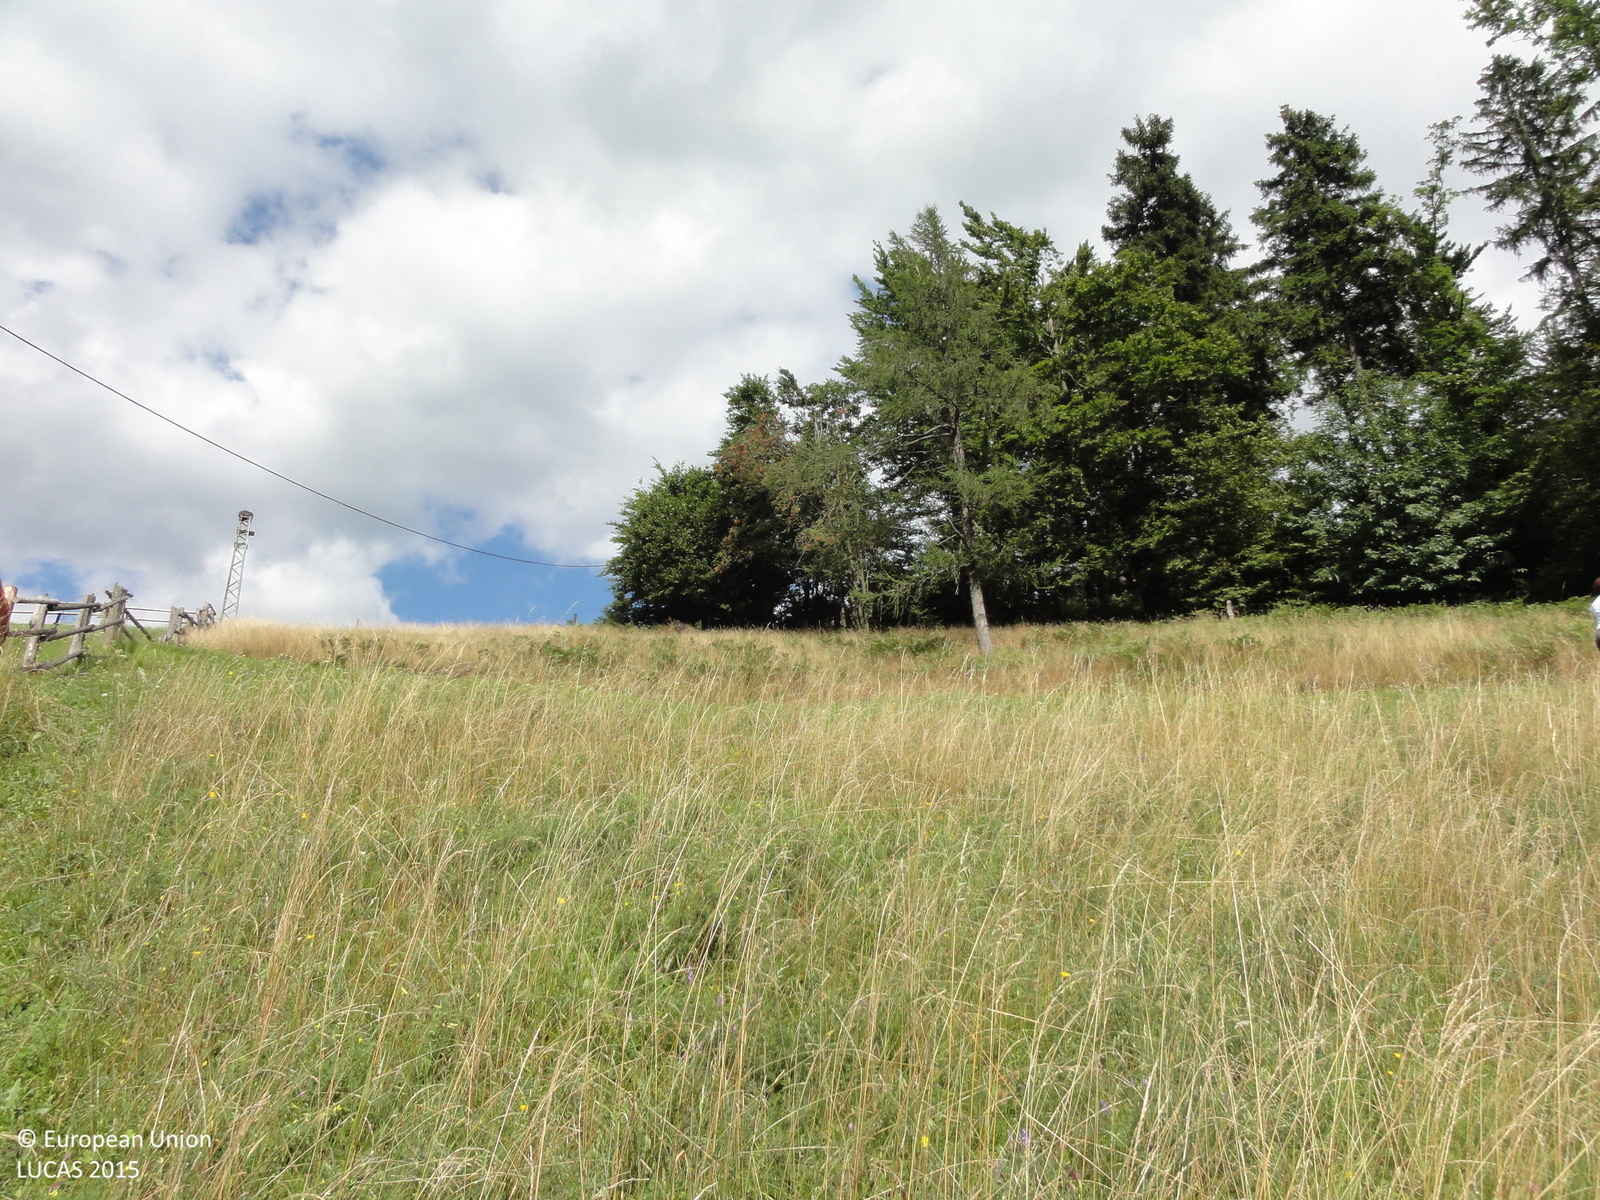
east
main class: Grassland
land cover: Grassland without tree/shrub cover
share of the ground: > 75 %
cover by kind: herbaceous plants 100 %
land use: Agriculture (excluding fallow land and kitchen gardens)
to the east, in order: Grassland without tree/shrub cover; Electric lines; Grassland without tree/shrub cover; Tracks; Grassland without tree/shrub cover; Spruce dominated mixed woodland; Tracks; Spruce dominated mixed woodland; Tracks; Fences; Grassland without tree/shrub cover; Fences; Tracks; Spruce dominated mixed woodland; Tracks; Spruce dominated mixed woodland
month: July
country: SI
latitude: 46.4275
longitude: 15.1120
